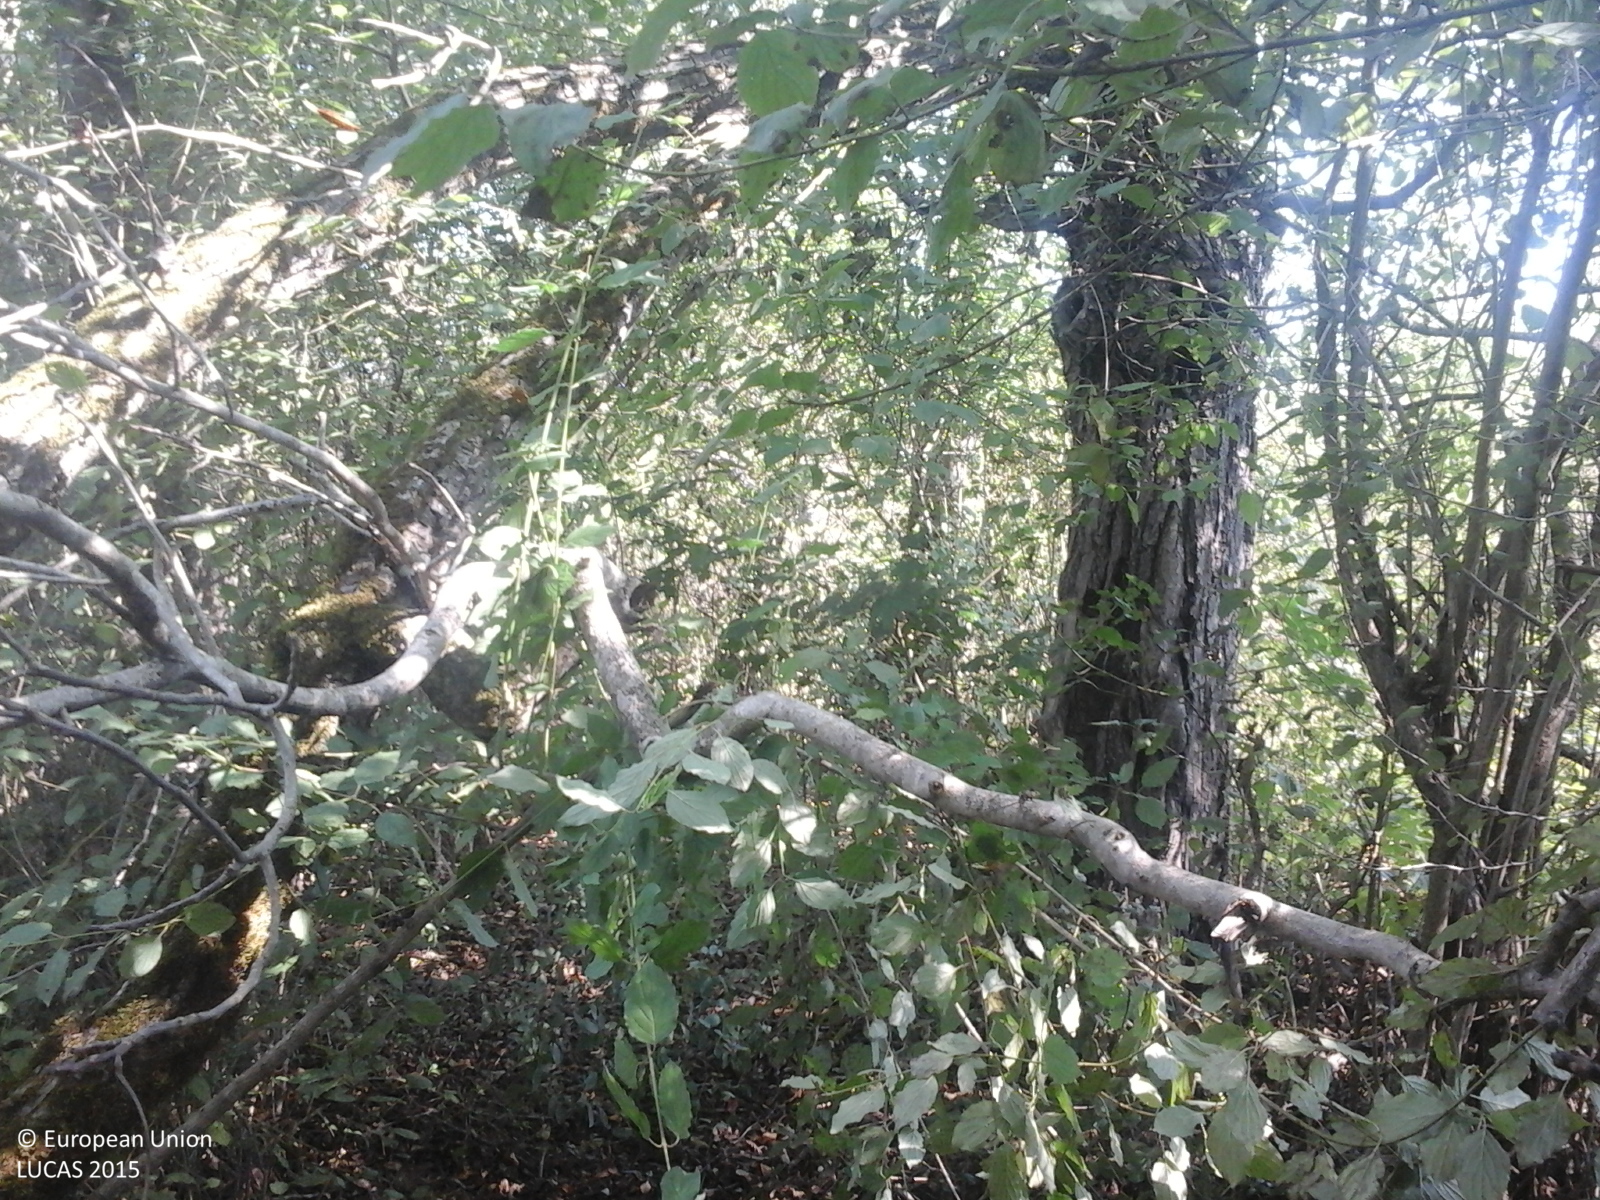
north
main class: Woodland
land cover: Broadleaved woodland
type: non-riverine alder, birch or aspen forest
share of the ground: > 75 %
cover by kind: broadleaved forest trees 100 %
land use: Forestry
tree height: > 5 m
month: August
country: RO
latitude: 46.4311
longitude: 22.2148
